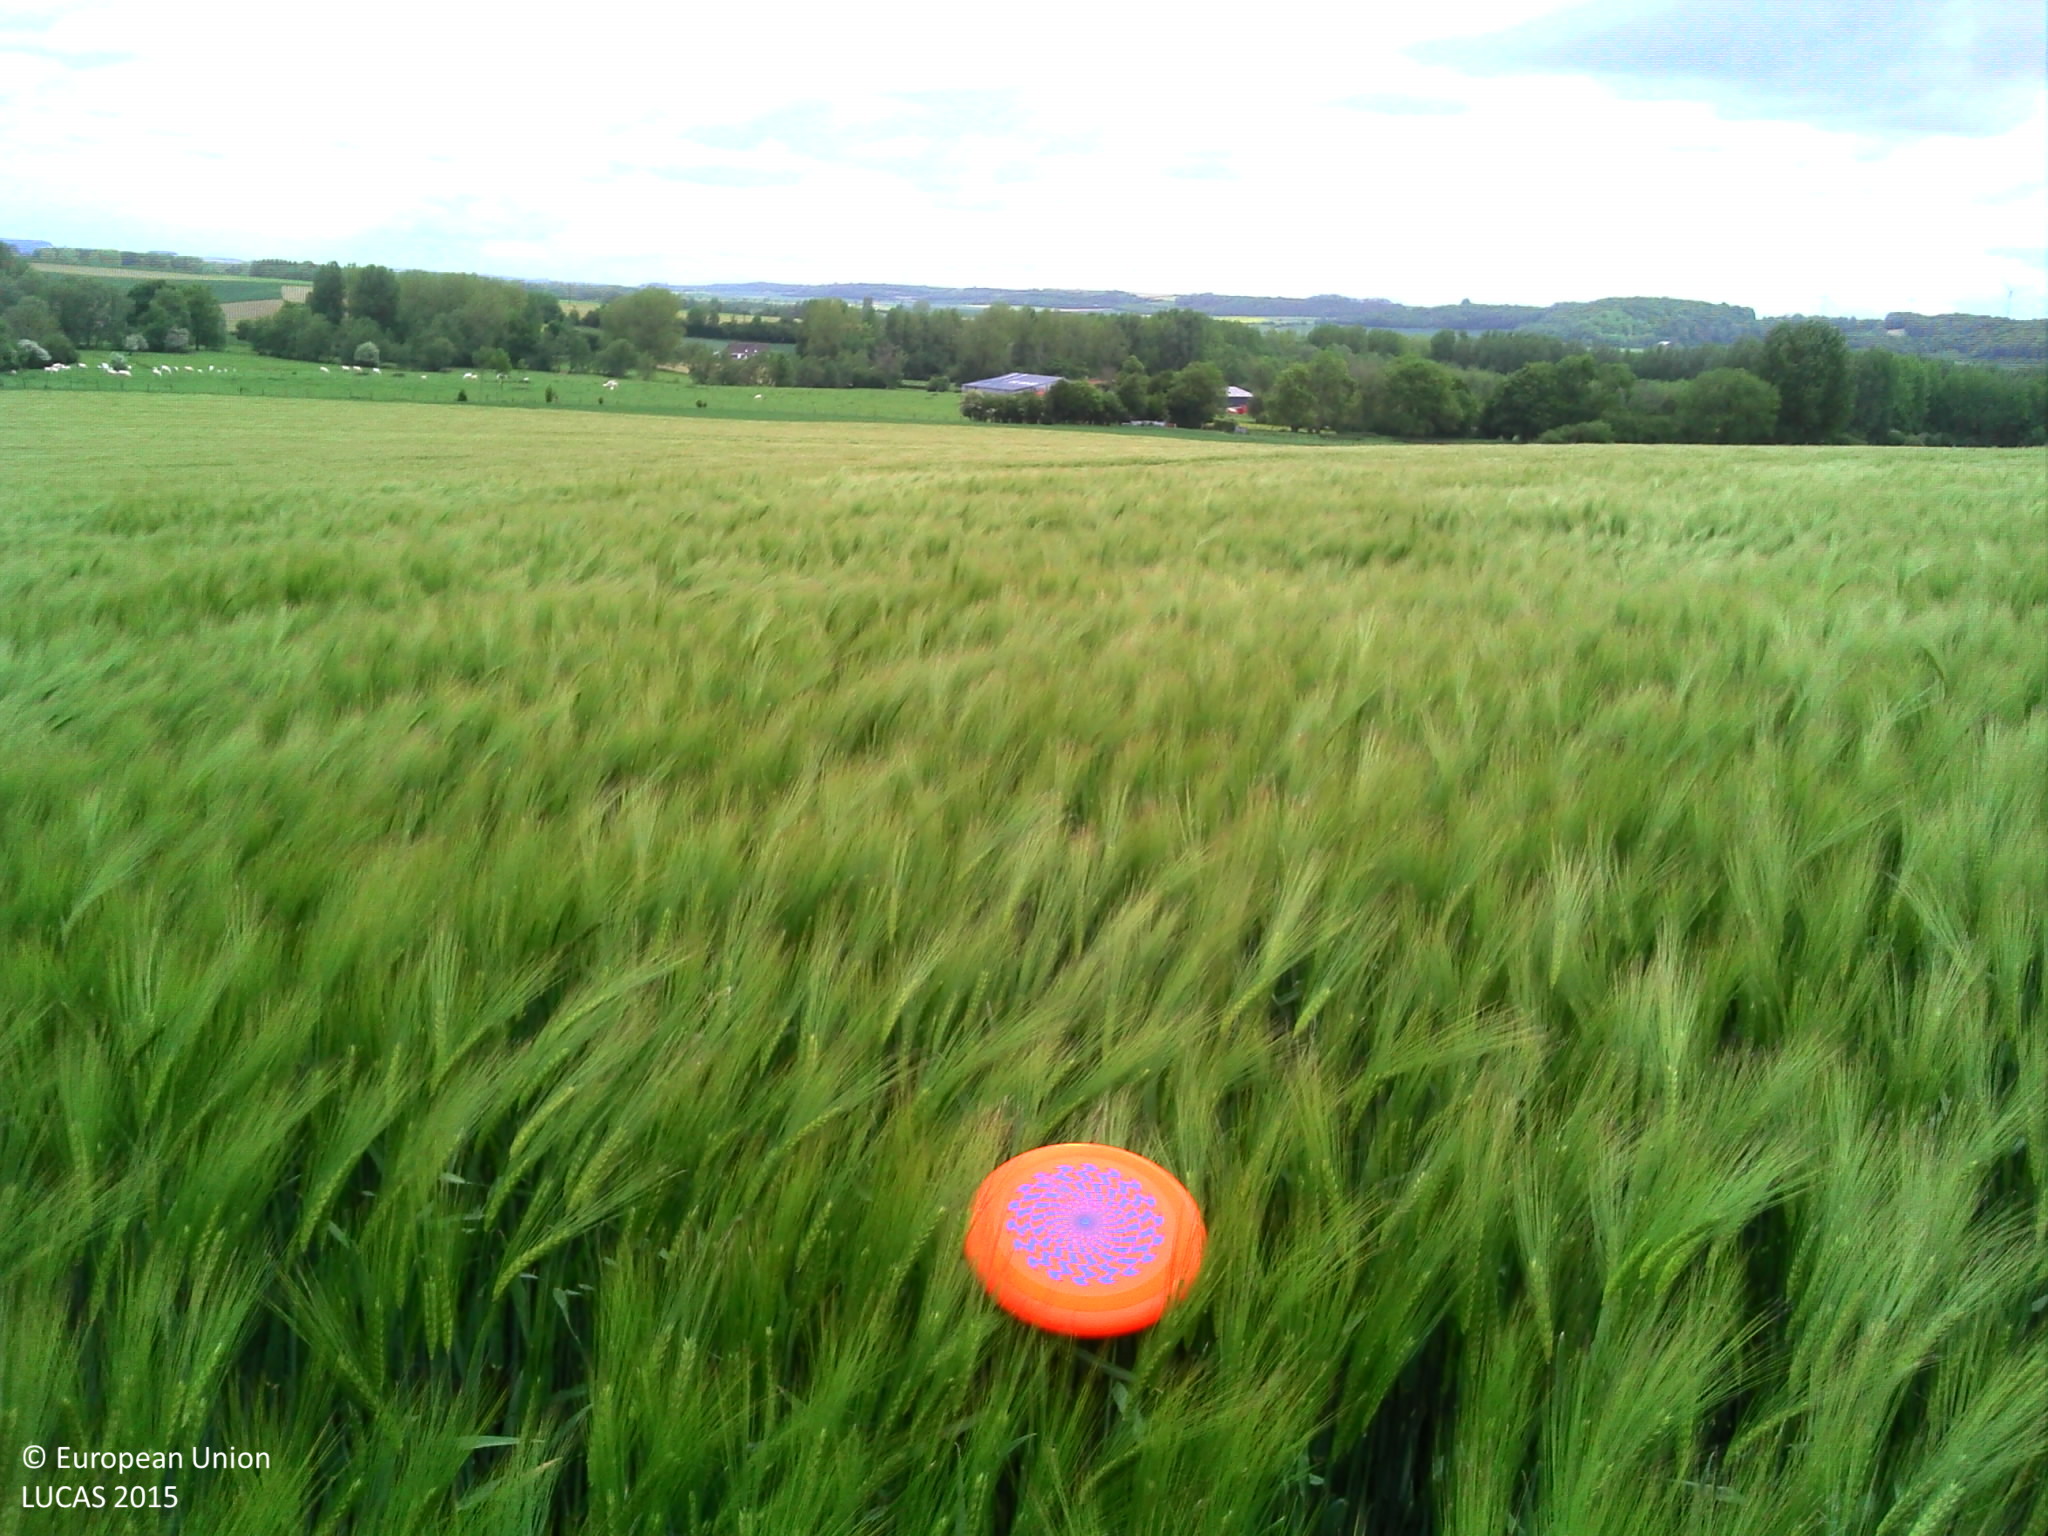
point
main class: Cropland
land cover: Barley
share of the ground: > 75 %
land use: Agriculture (excluding fallow land and kitchen gardens)
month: May
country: FR
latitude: 50.5102
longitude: 2.1590
